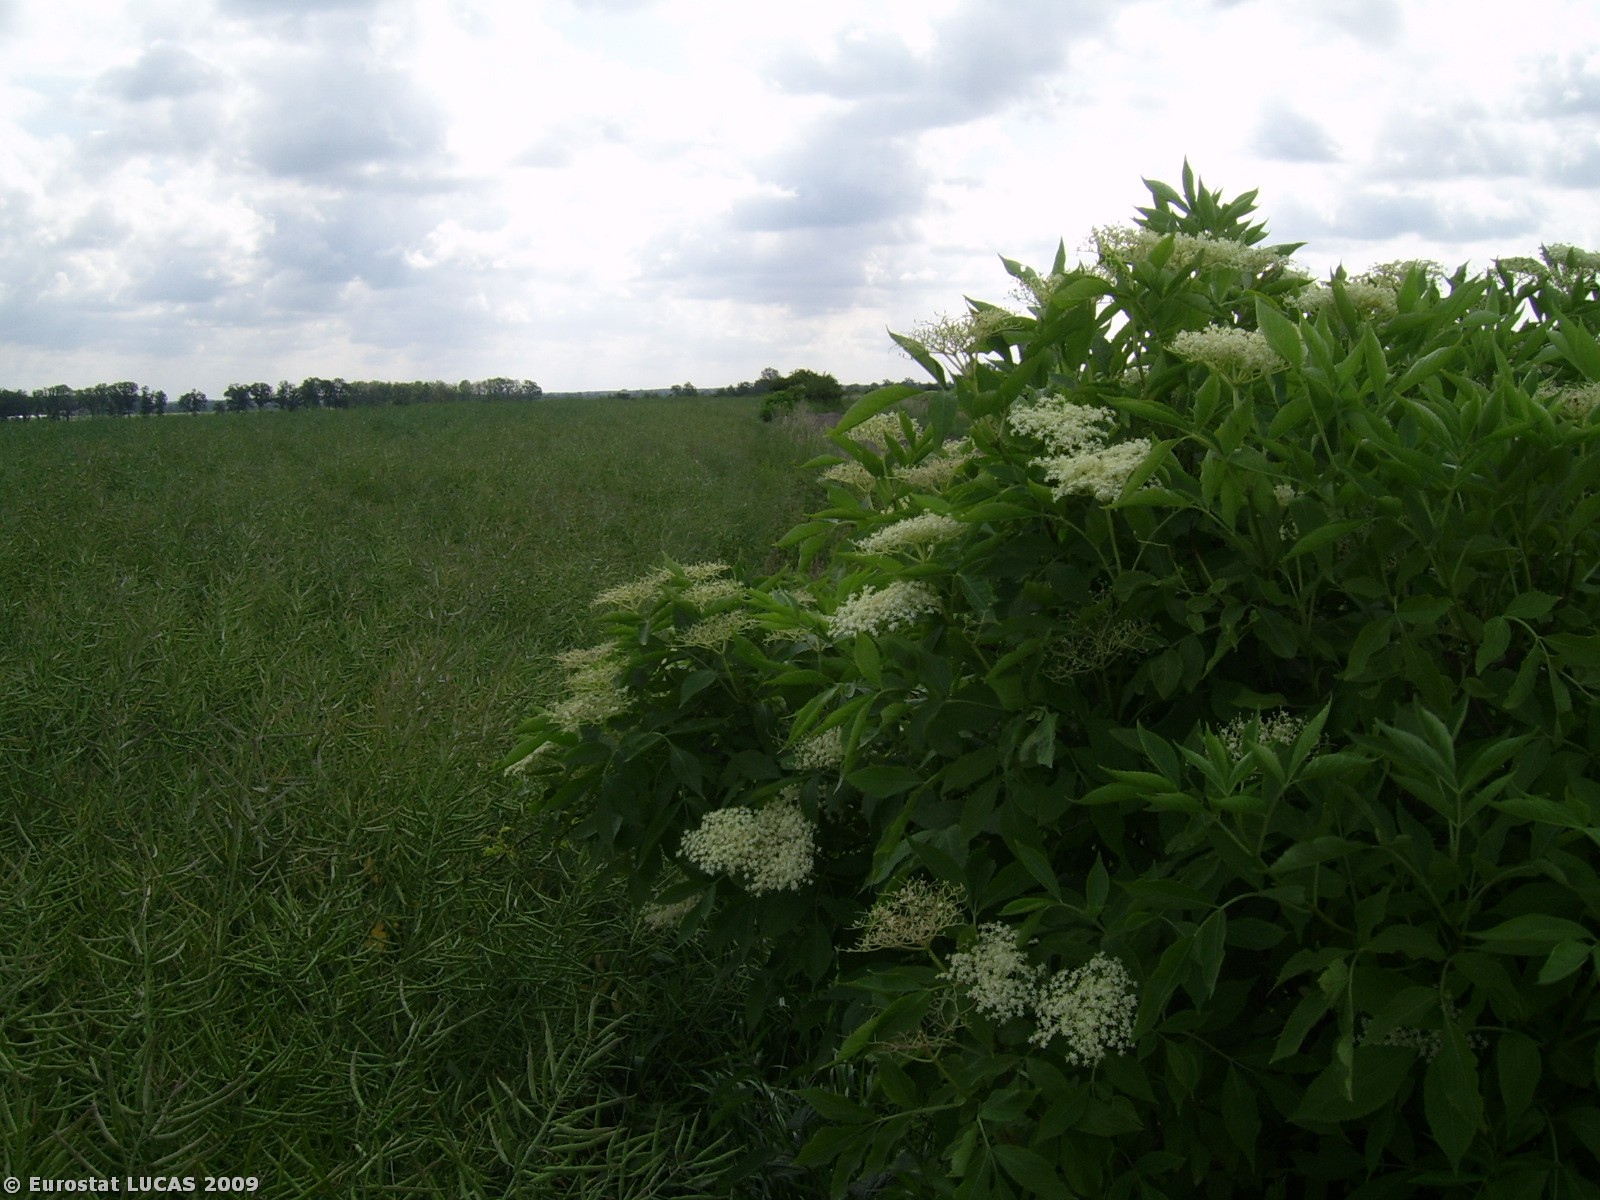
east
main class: Cropland
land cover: Rape and turnip rape
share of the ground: > 75 %
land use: Agriculture (excluding fallow land and kitchen gardens)
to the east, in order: Rape and turnip rape; Common wheat
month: June
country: PL
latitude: 51.9421
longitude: 17.7679
